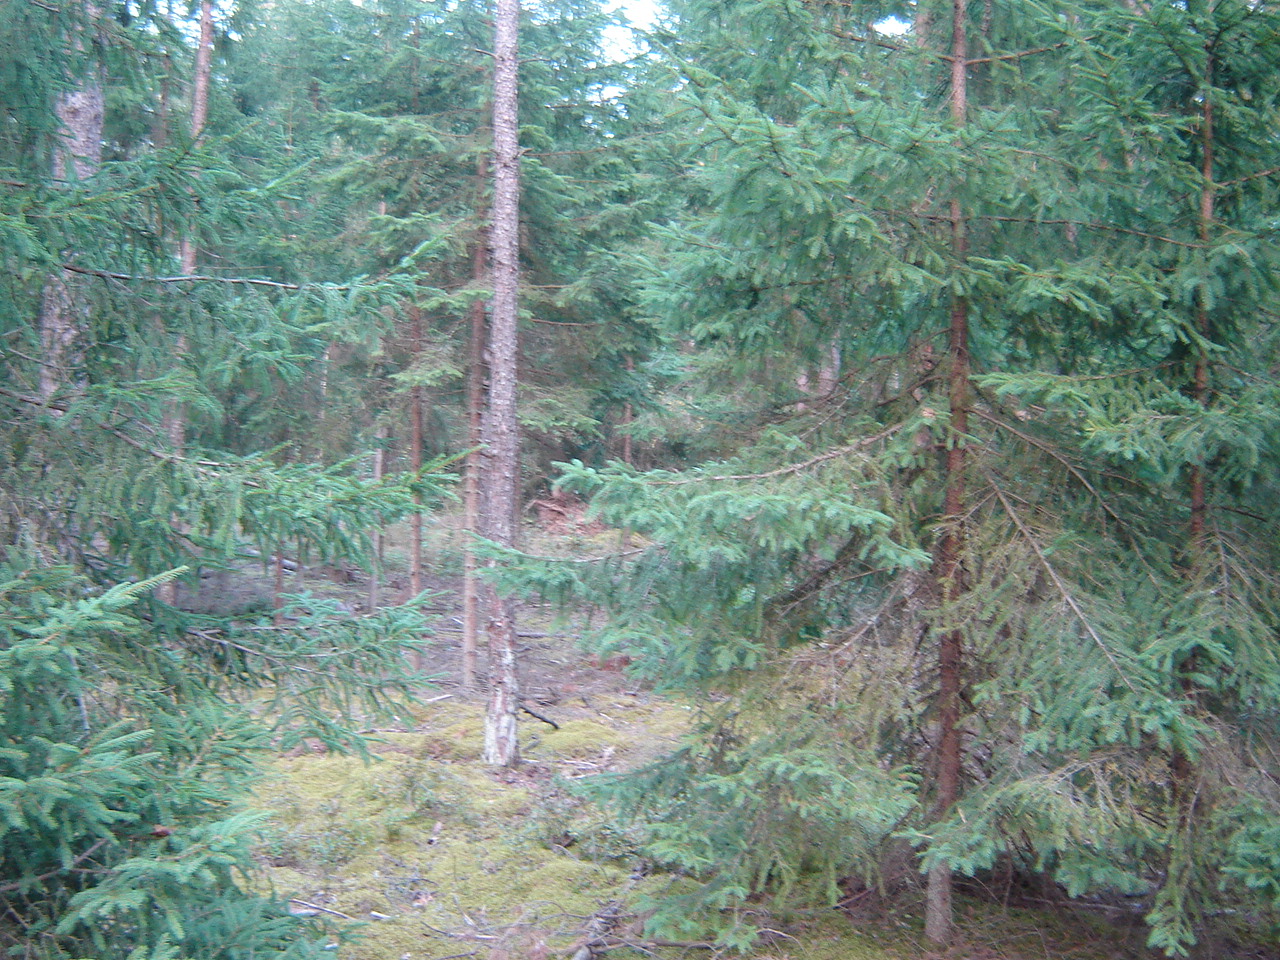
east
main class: Woodland
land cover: Pine dominated coniferous woodland
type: hemiboreal forest and nemoral coniferous forest and mixed broadleaved-coniferous forest
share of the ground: 50 - 75 %
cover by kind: coniferous forest trees 60 %, lichens and mosses 35 %, broadleaved forest trees 5 %
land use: Forestry
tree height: > 5 m
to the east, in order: Pine dominated coniferous woodland; Other structural elements; Pine dominated mixed woodland; Tracks; Pine dominated coniferous woodland; Pine dominated mixed woodland; Tracks
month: September
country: LT
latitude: 54.4080
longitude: 24.7927
